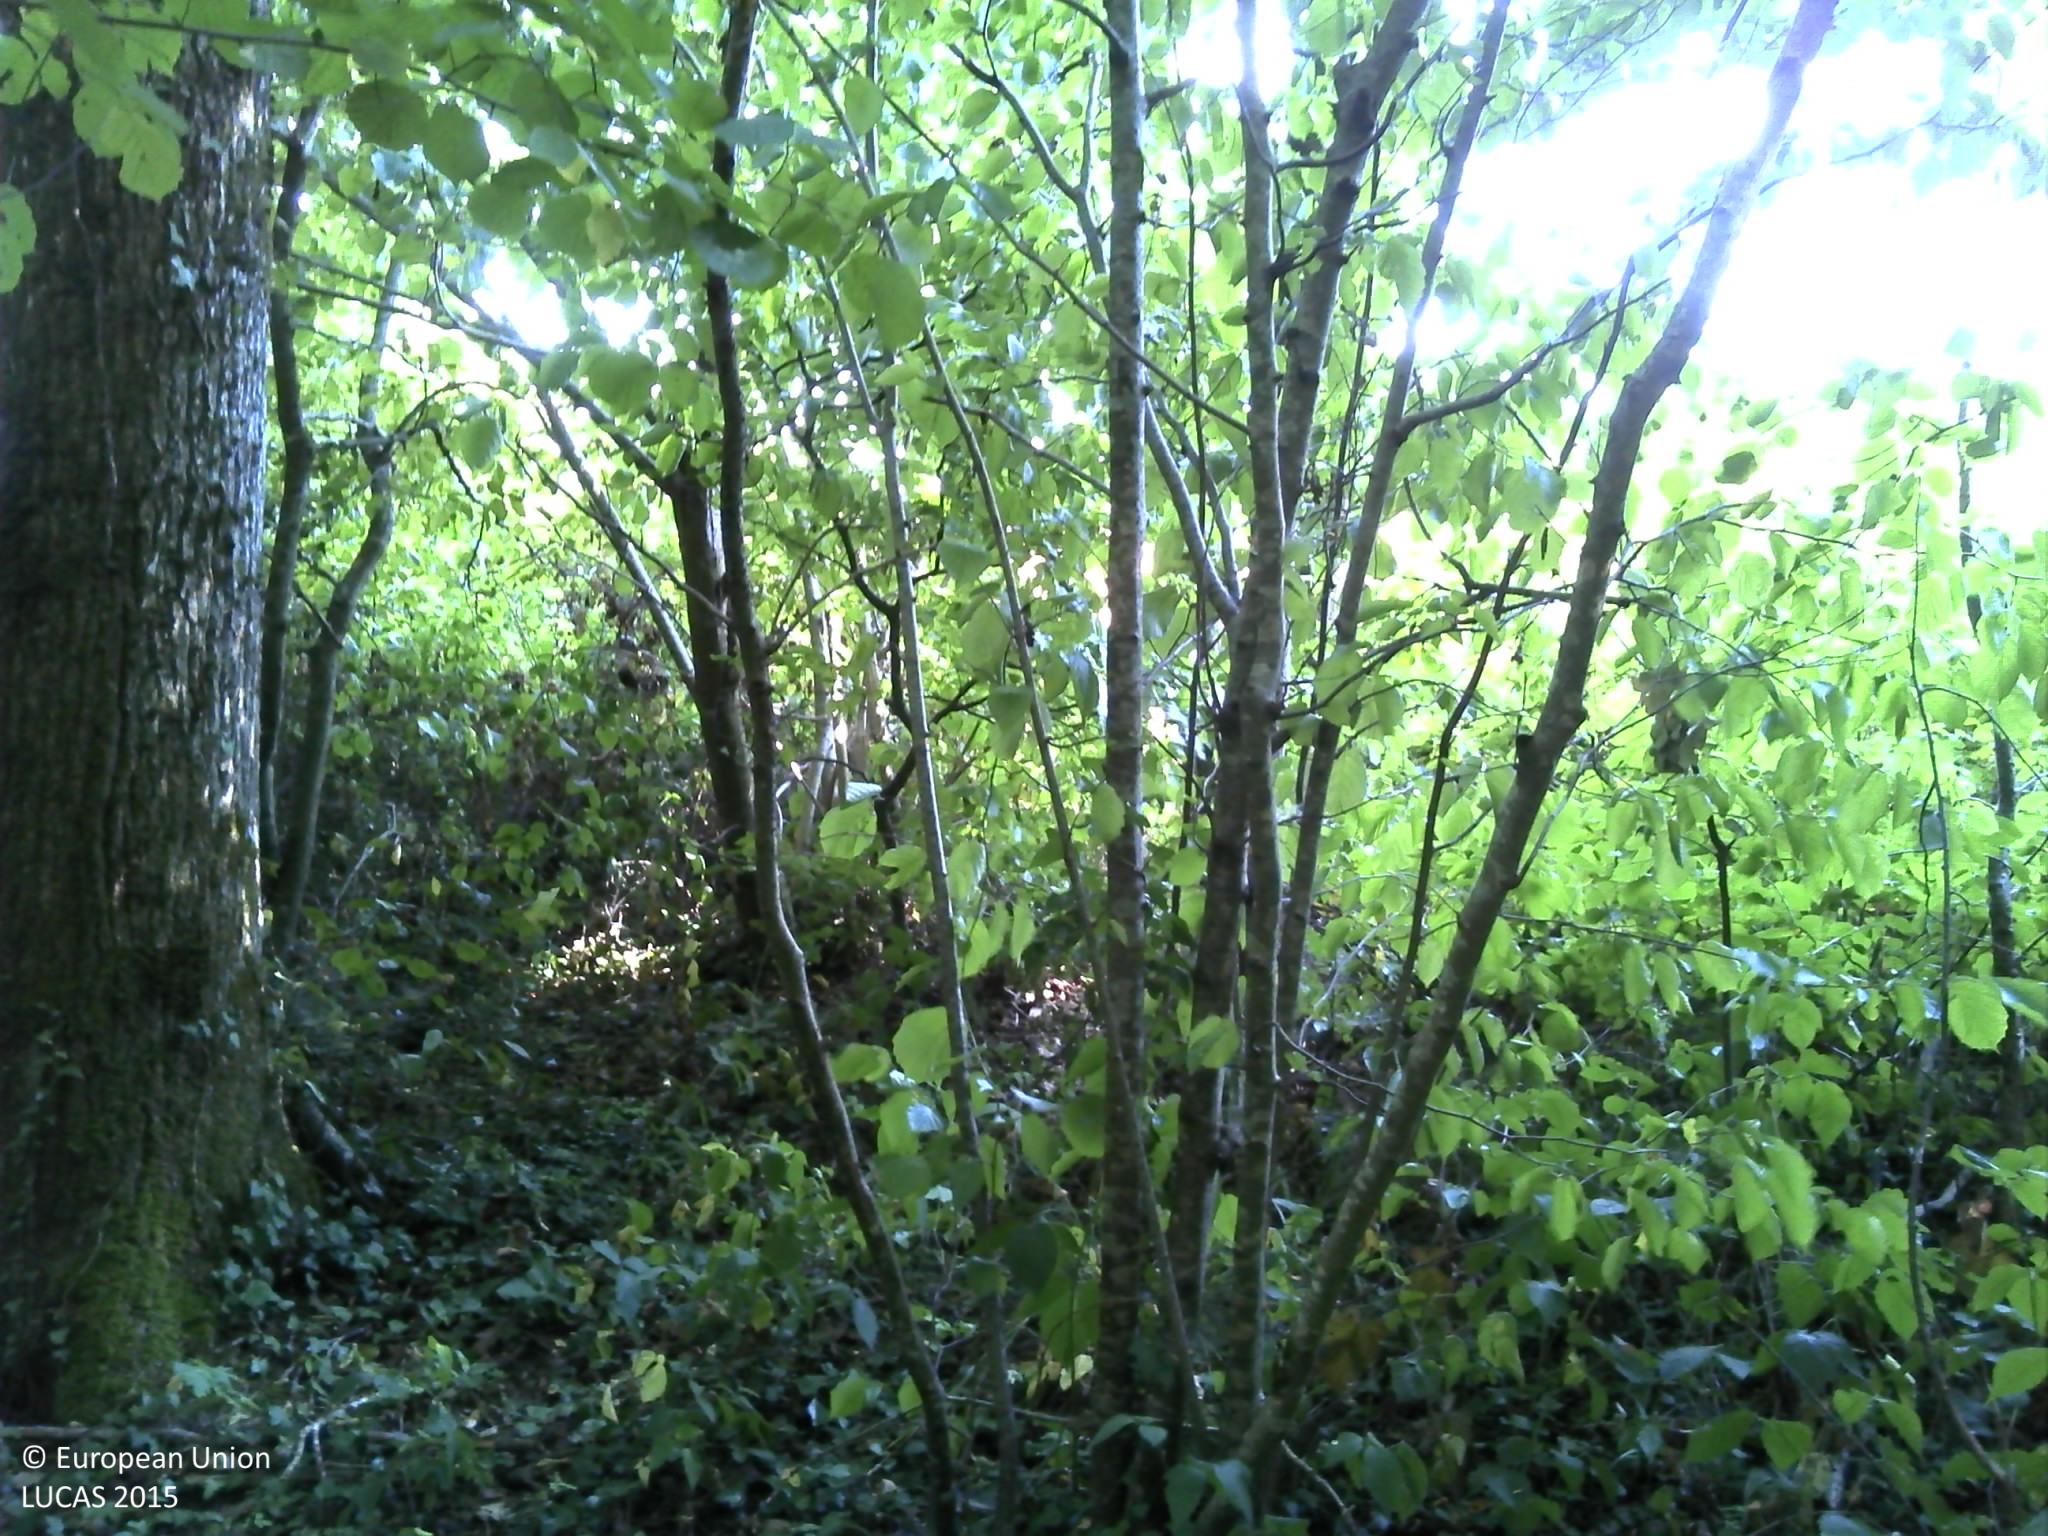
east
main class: Woodland
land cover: Broadleaved woodland
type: beech forest
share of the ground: > 75 %
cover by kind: broadleaved forest trees 90 %, coniferous forest trees 10 %
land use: Forestry
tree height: > 5 m
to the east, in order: Broadleaved woodland; Fences; Grassland without tree/shrub cover; Fences; Grassland without tree/shrub cover; Lines of trees; Grassland without tree/shrub cover
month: July
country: FR
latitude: 48.8800
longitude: 4.8842
